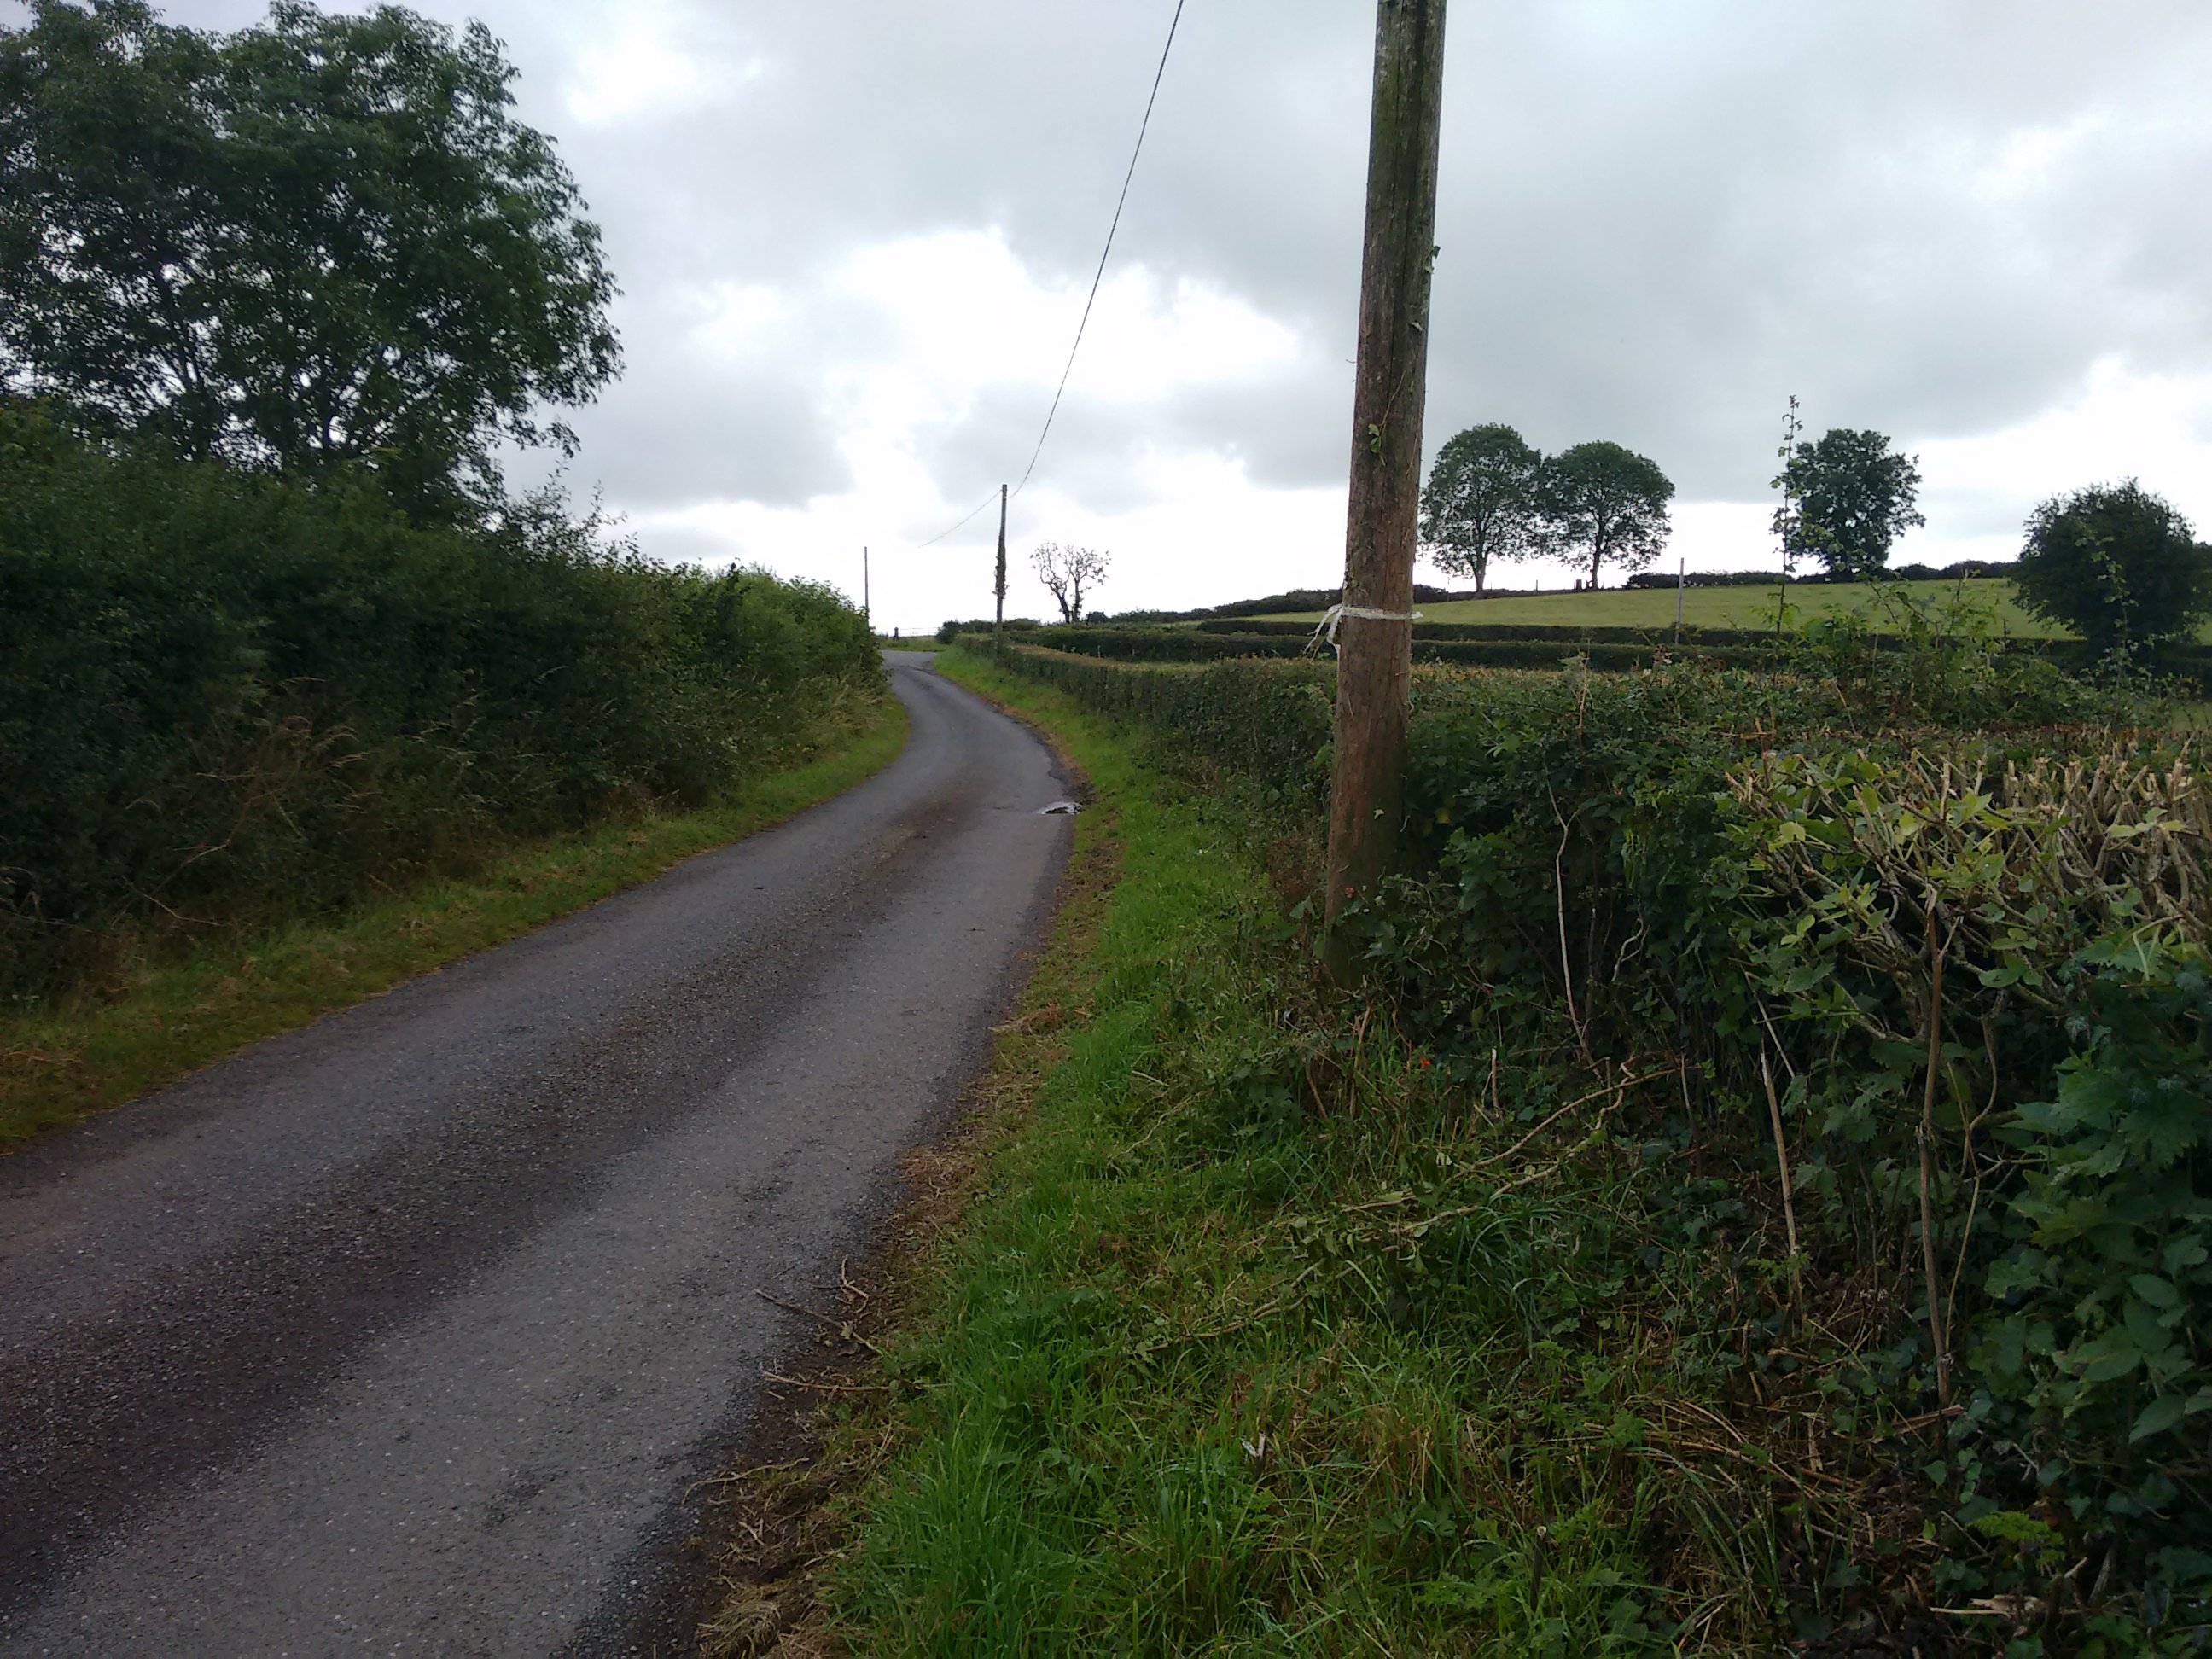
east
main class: Grassland
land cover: Grassland without tree/shrub cover
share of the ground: > 75 %
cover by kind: herbaceous plants 100 %
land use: Agriculture (excluding fallow land and kitchen gardens)
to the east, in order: Grassland without tree/shrub cover; Fences; Managed hedges; Grass margins; Paved roads, cycling and walking lanes; Grass margins; Managed hedges; Electric lines; Fences; Grassland without tree/shrub cover; Managed hedges; Grassland without tree/shrub cover
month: August
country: GB
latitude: 54.4026
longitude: -6.8175
